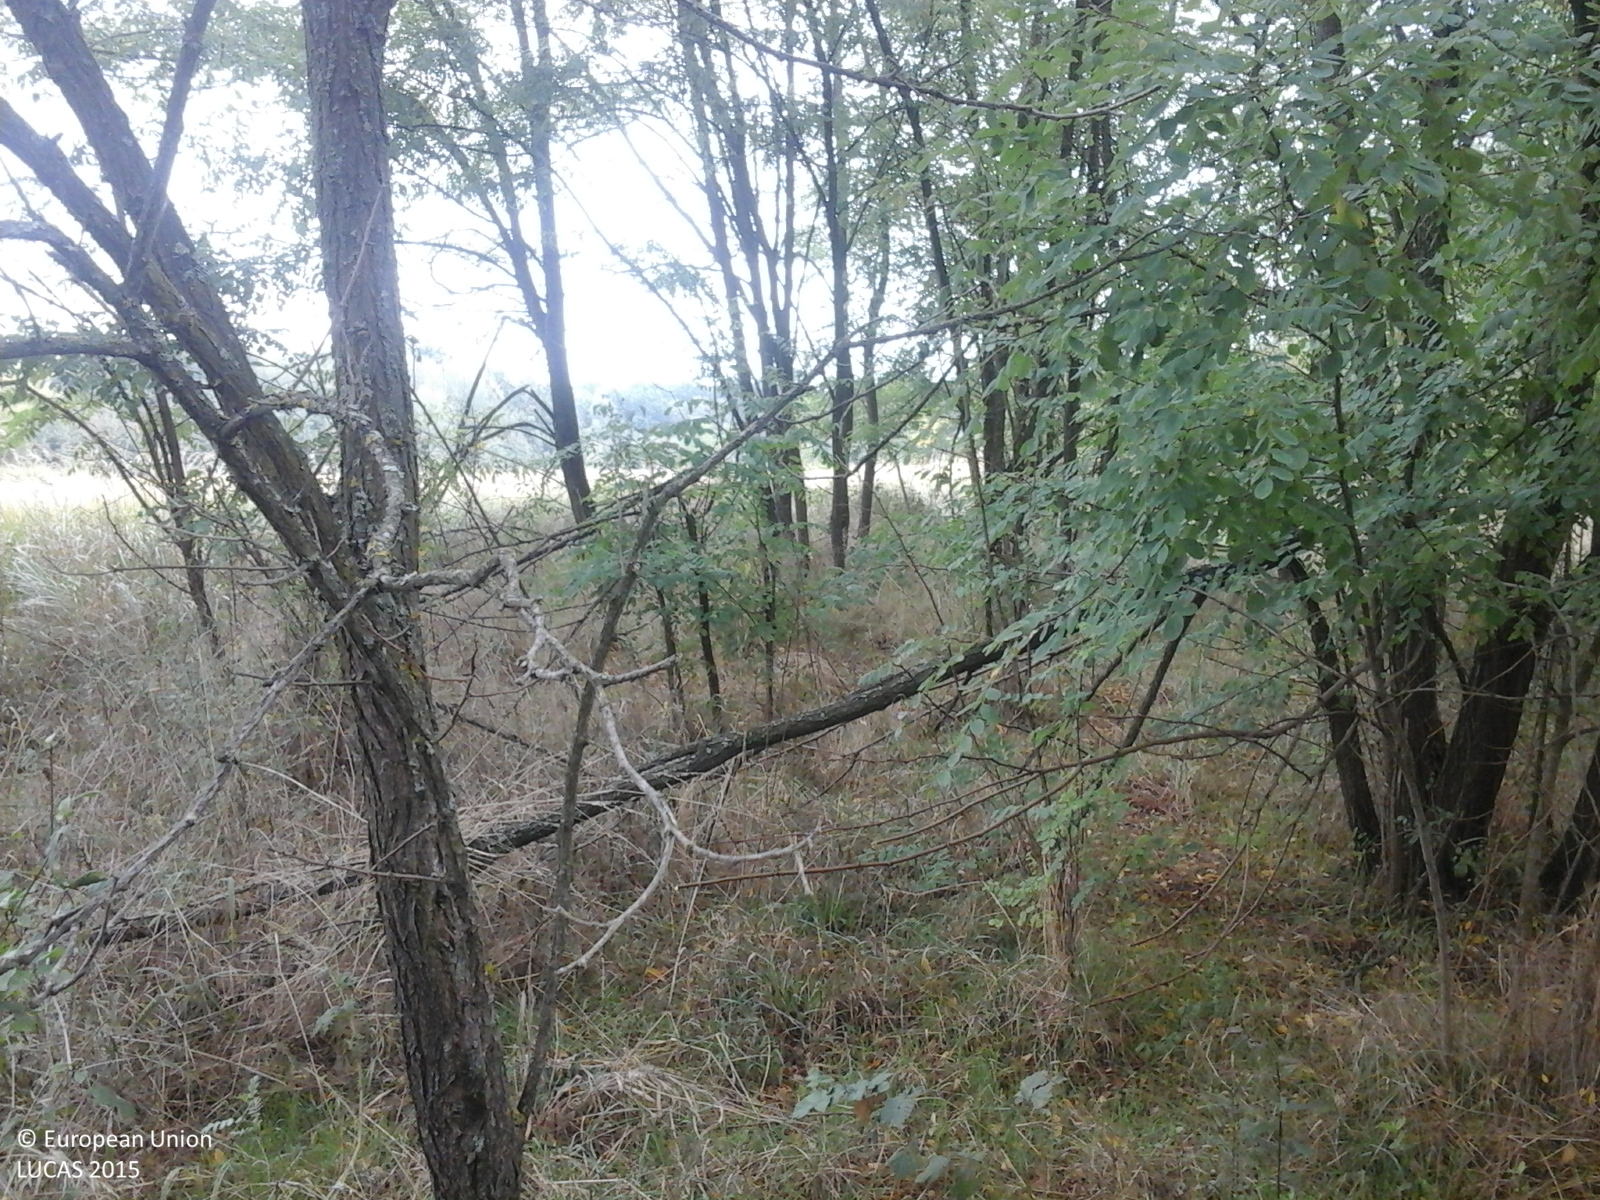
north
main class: Woodland
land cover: Broadleaved woodland
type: exotic forest
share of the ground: > 75 %
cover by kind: broadleaved forest trees 75 %, herbaceous plants 25 %
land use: Forestry
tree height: > 5 m
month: September
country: RO
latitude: 45.5055
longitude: 22.0315
